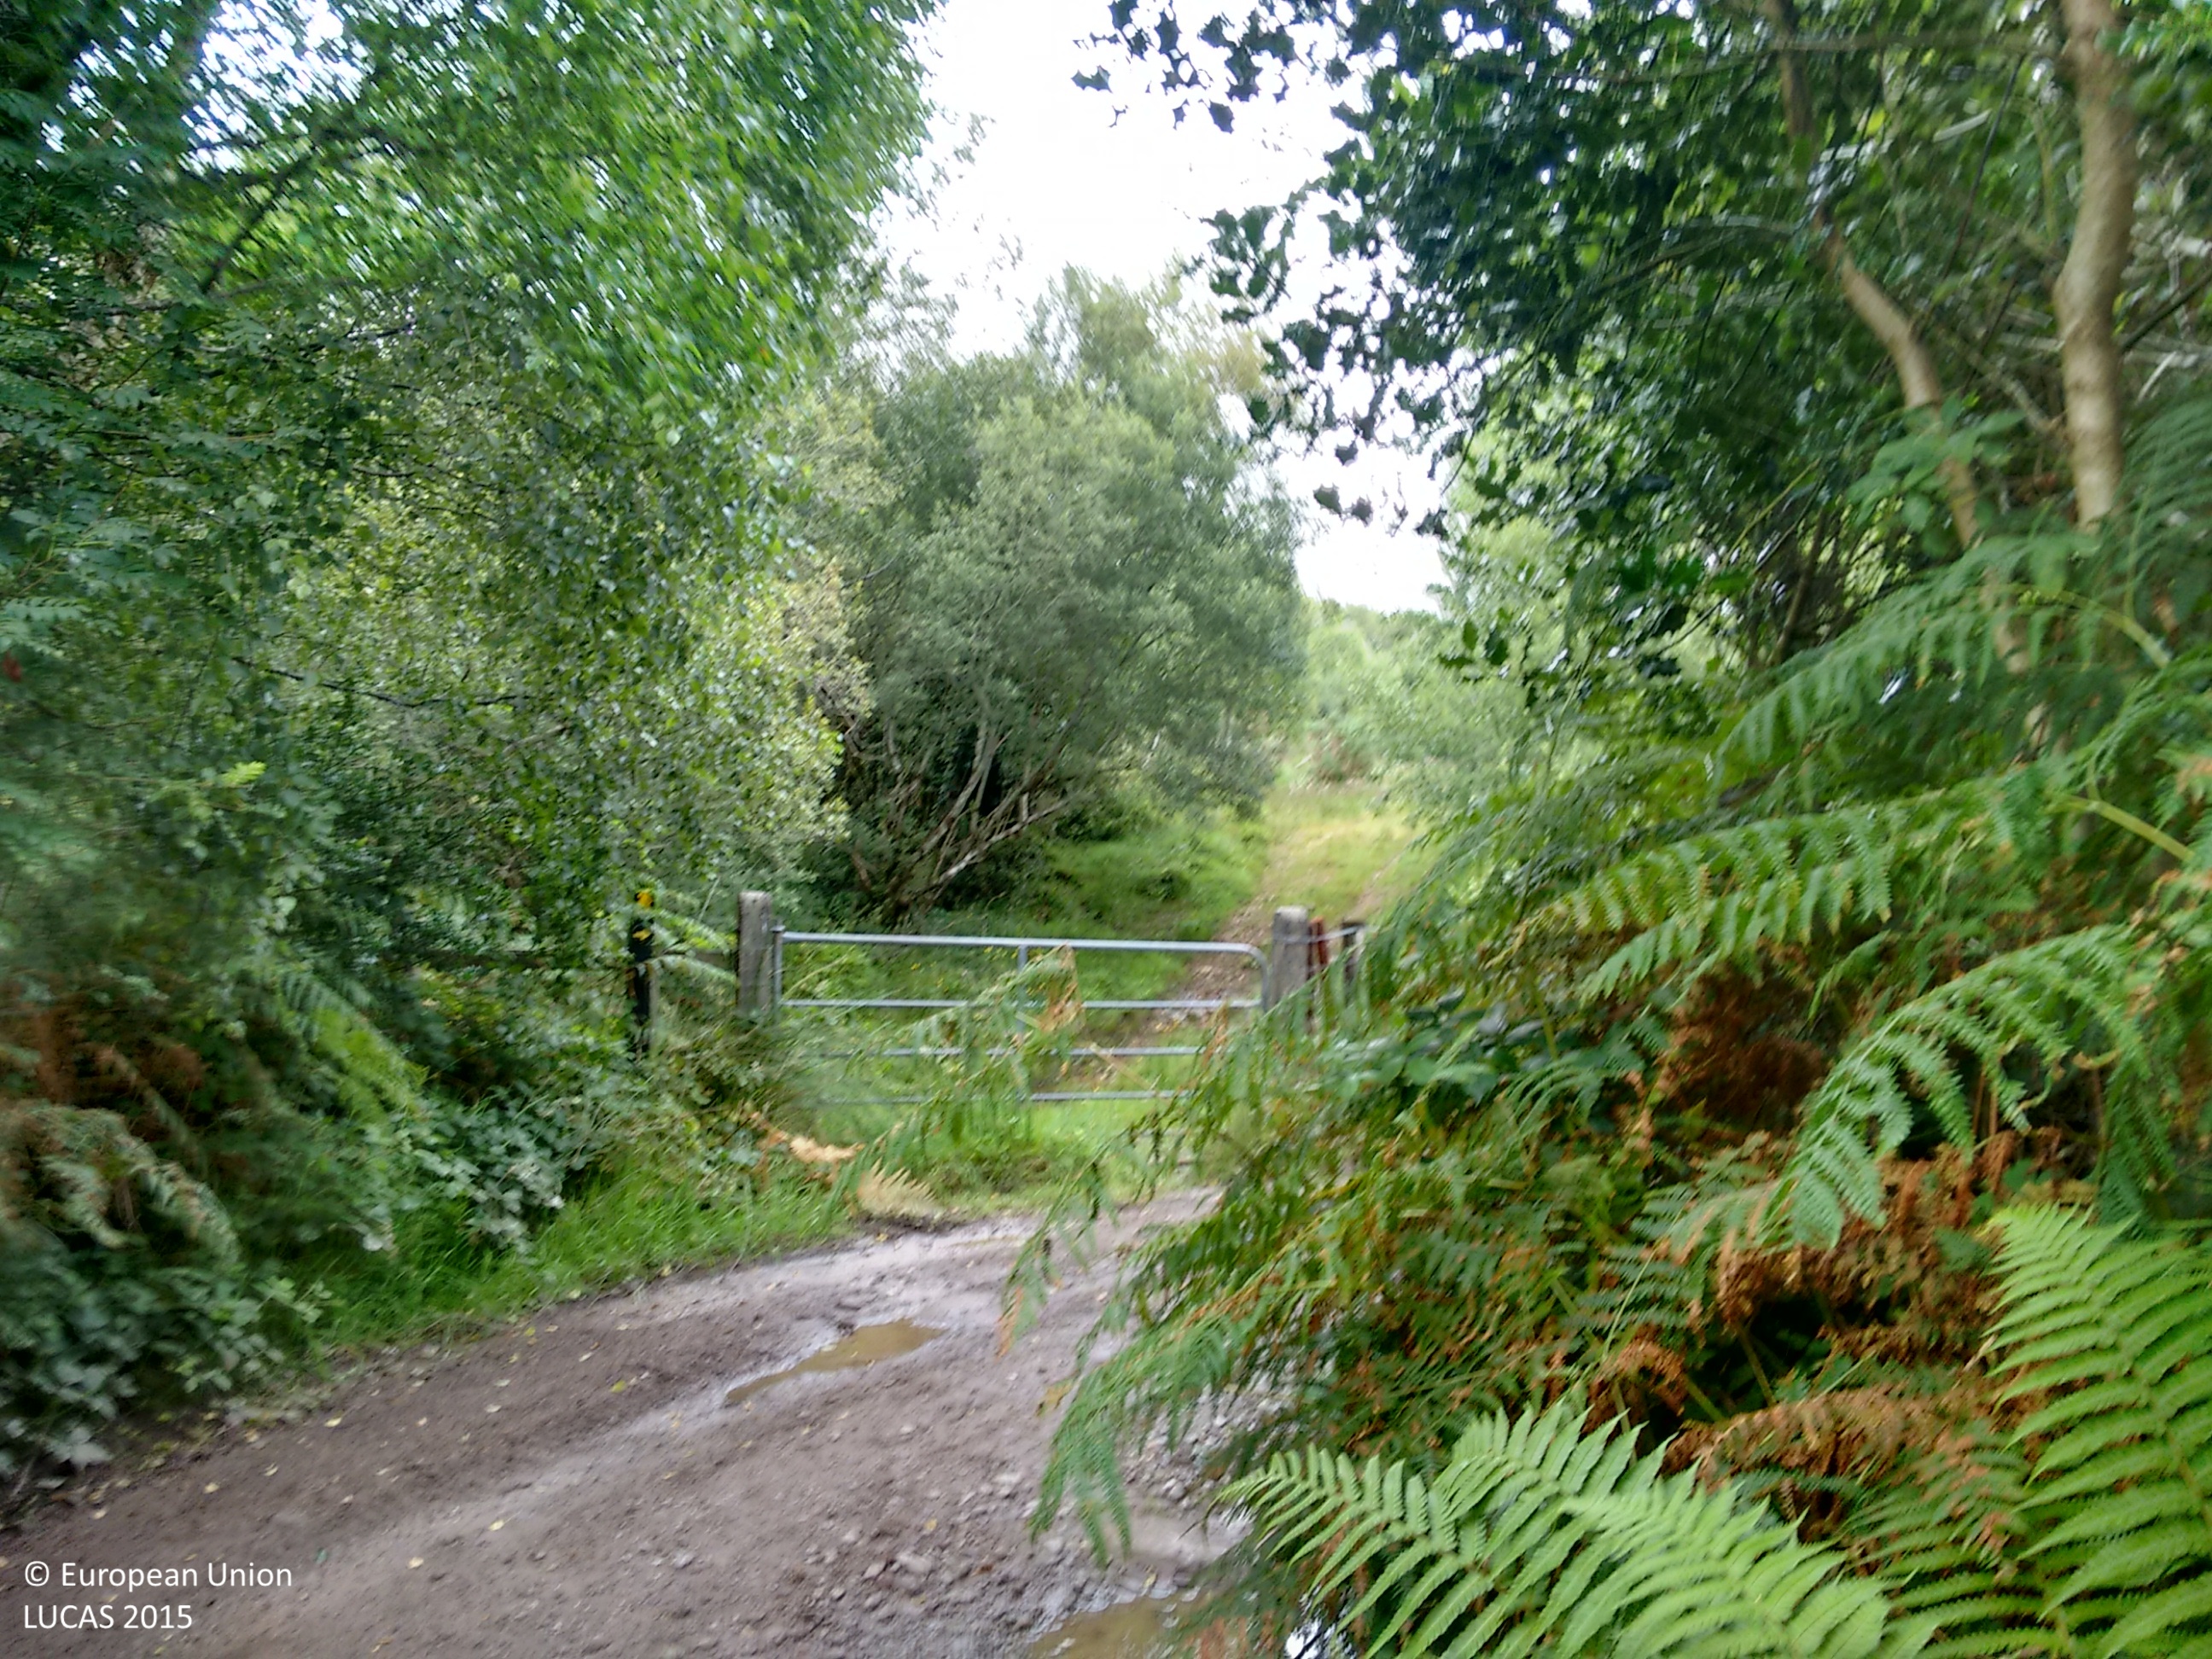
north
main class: Woodland
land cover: Broadleaved woodland
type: mesophytic deciduous forest
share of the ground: 50 - 75 %
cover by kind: broadleaved forest trees 65 %, herbaceous plants 20 %, consolidated bare surface 15 %
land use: Agriculture (excluding fallow land and kitchen gardens)
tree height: > 5 m
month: August
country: IE
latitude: 51.8765
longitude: -9.6605
